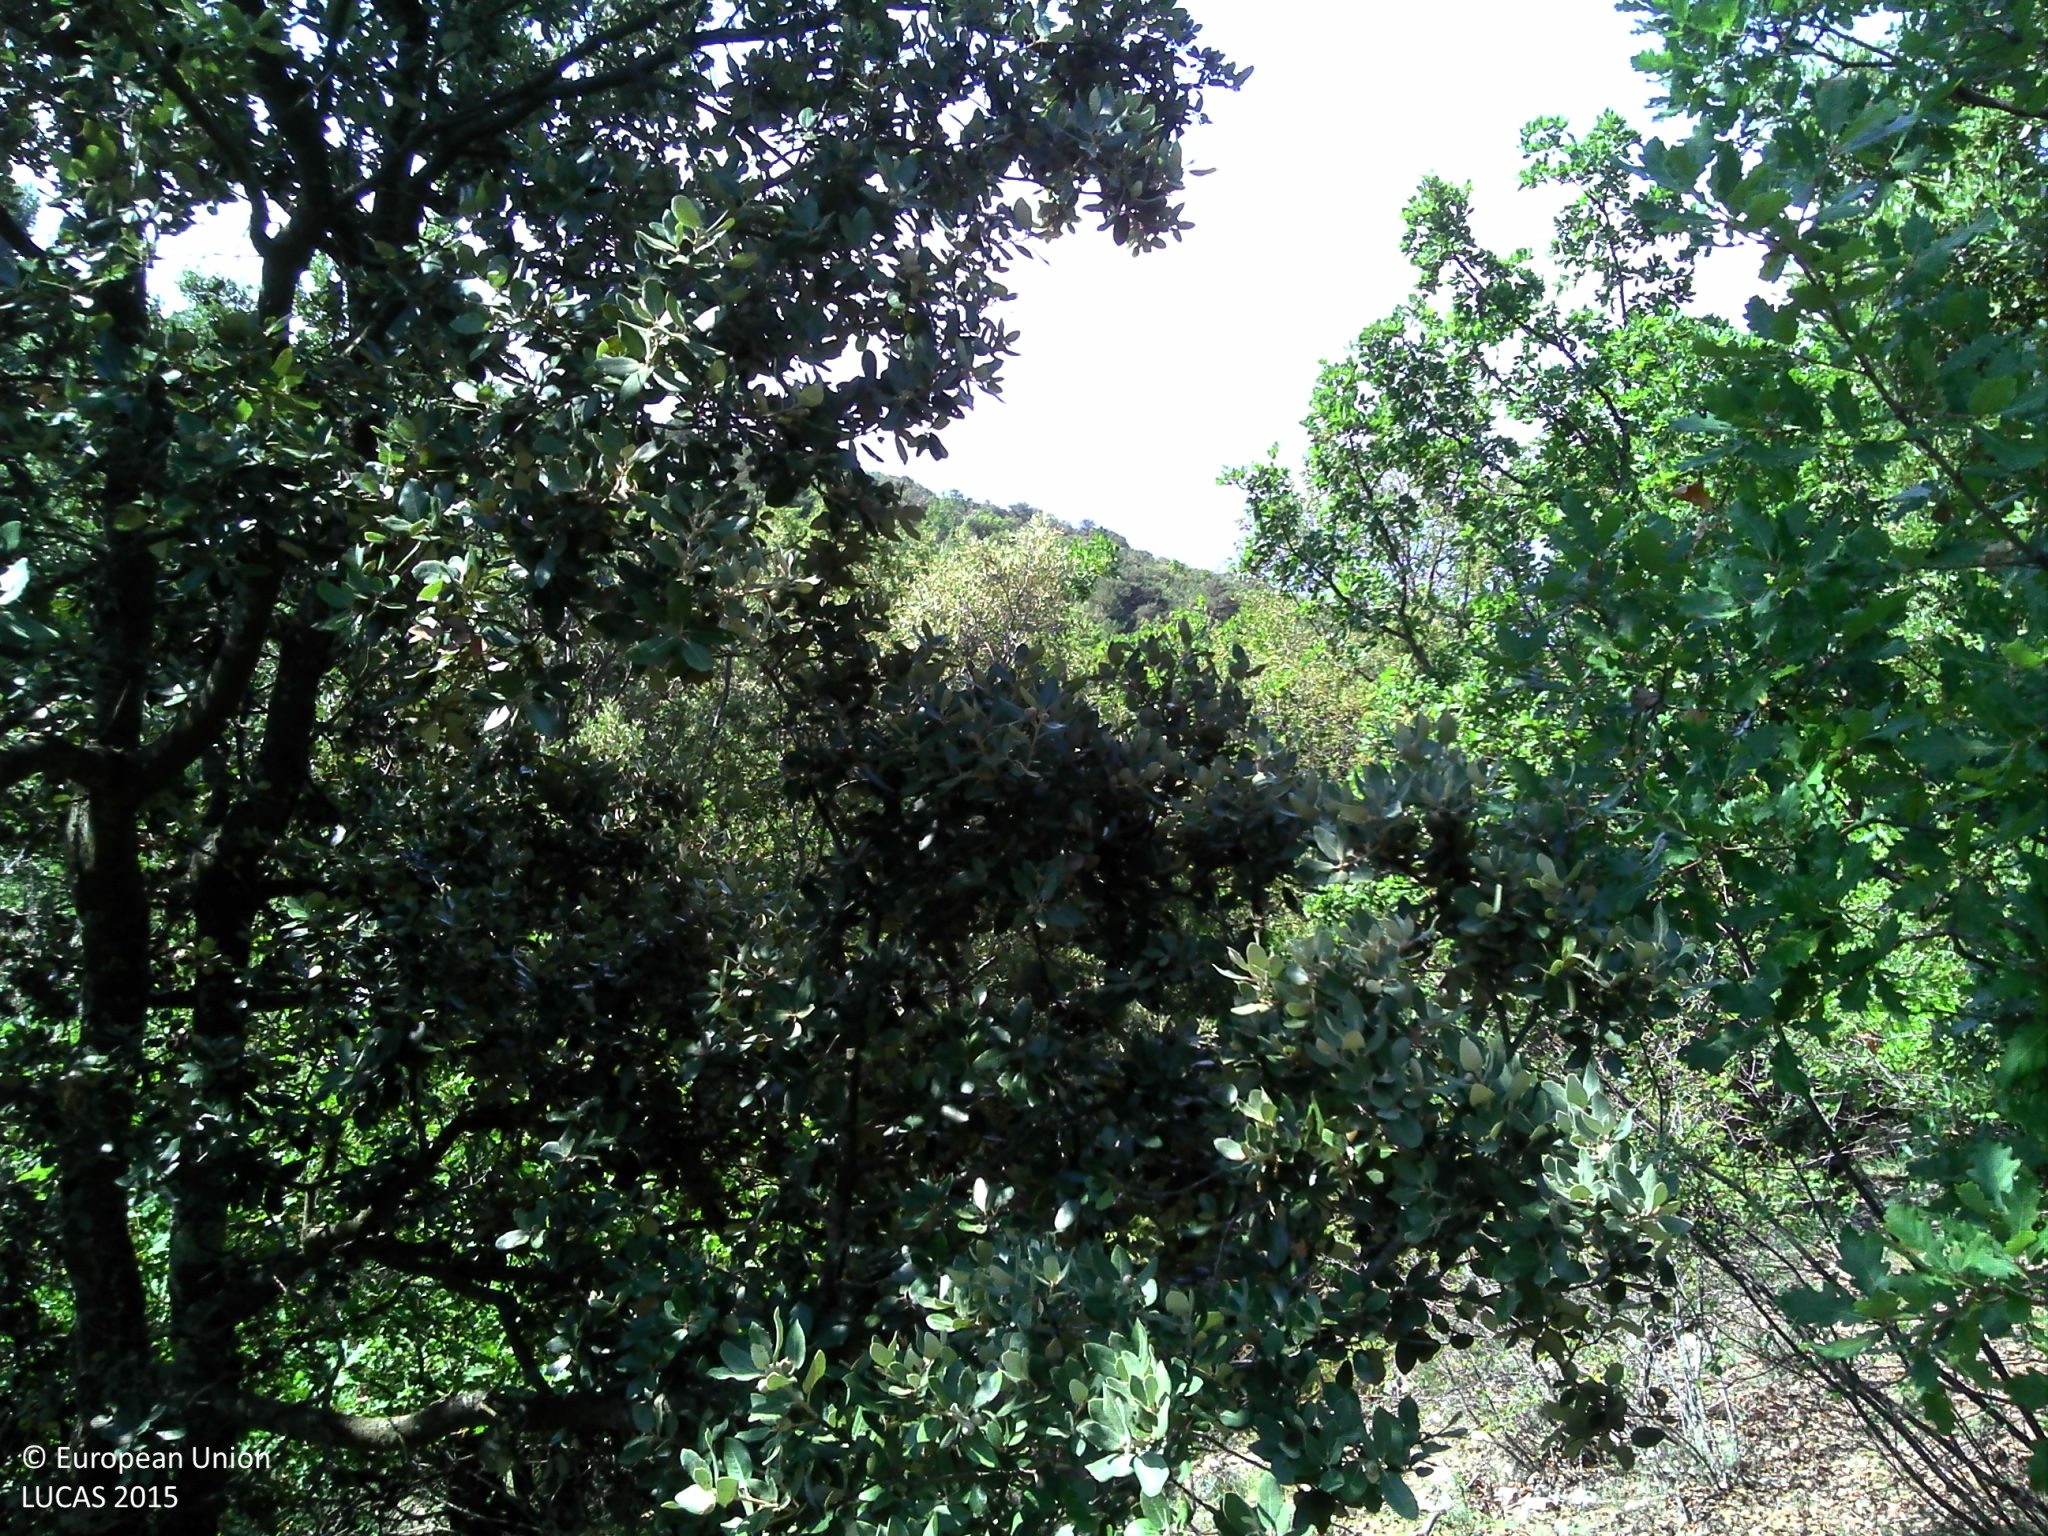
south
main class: Woodland
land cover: Broadleaved woodland
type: broadleaved evergreen forest
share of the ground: > 75 %
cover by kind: broadleaved forest trees 65 %, herbaceous plants 15 %, shrubs 10 %, lichens and mosses 10 %
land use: Semi-natural and natural areas not in use
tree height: > 5 m
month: August
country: FR
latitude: 43.9622
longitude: 5.4594
